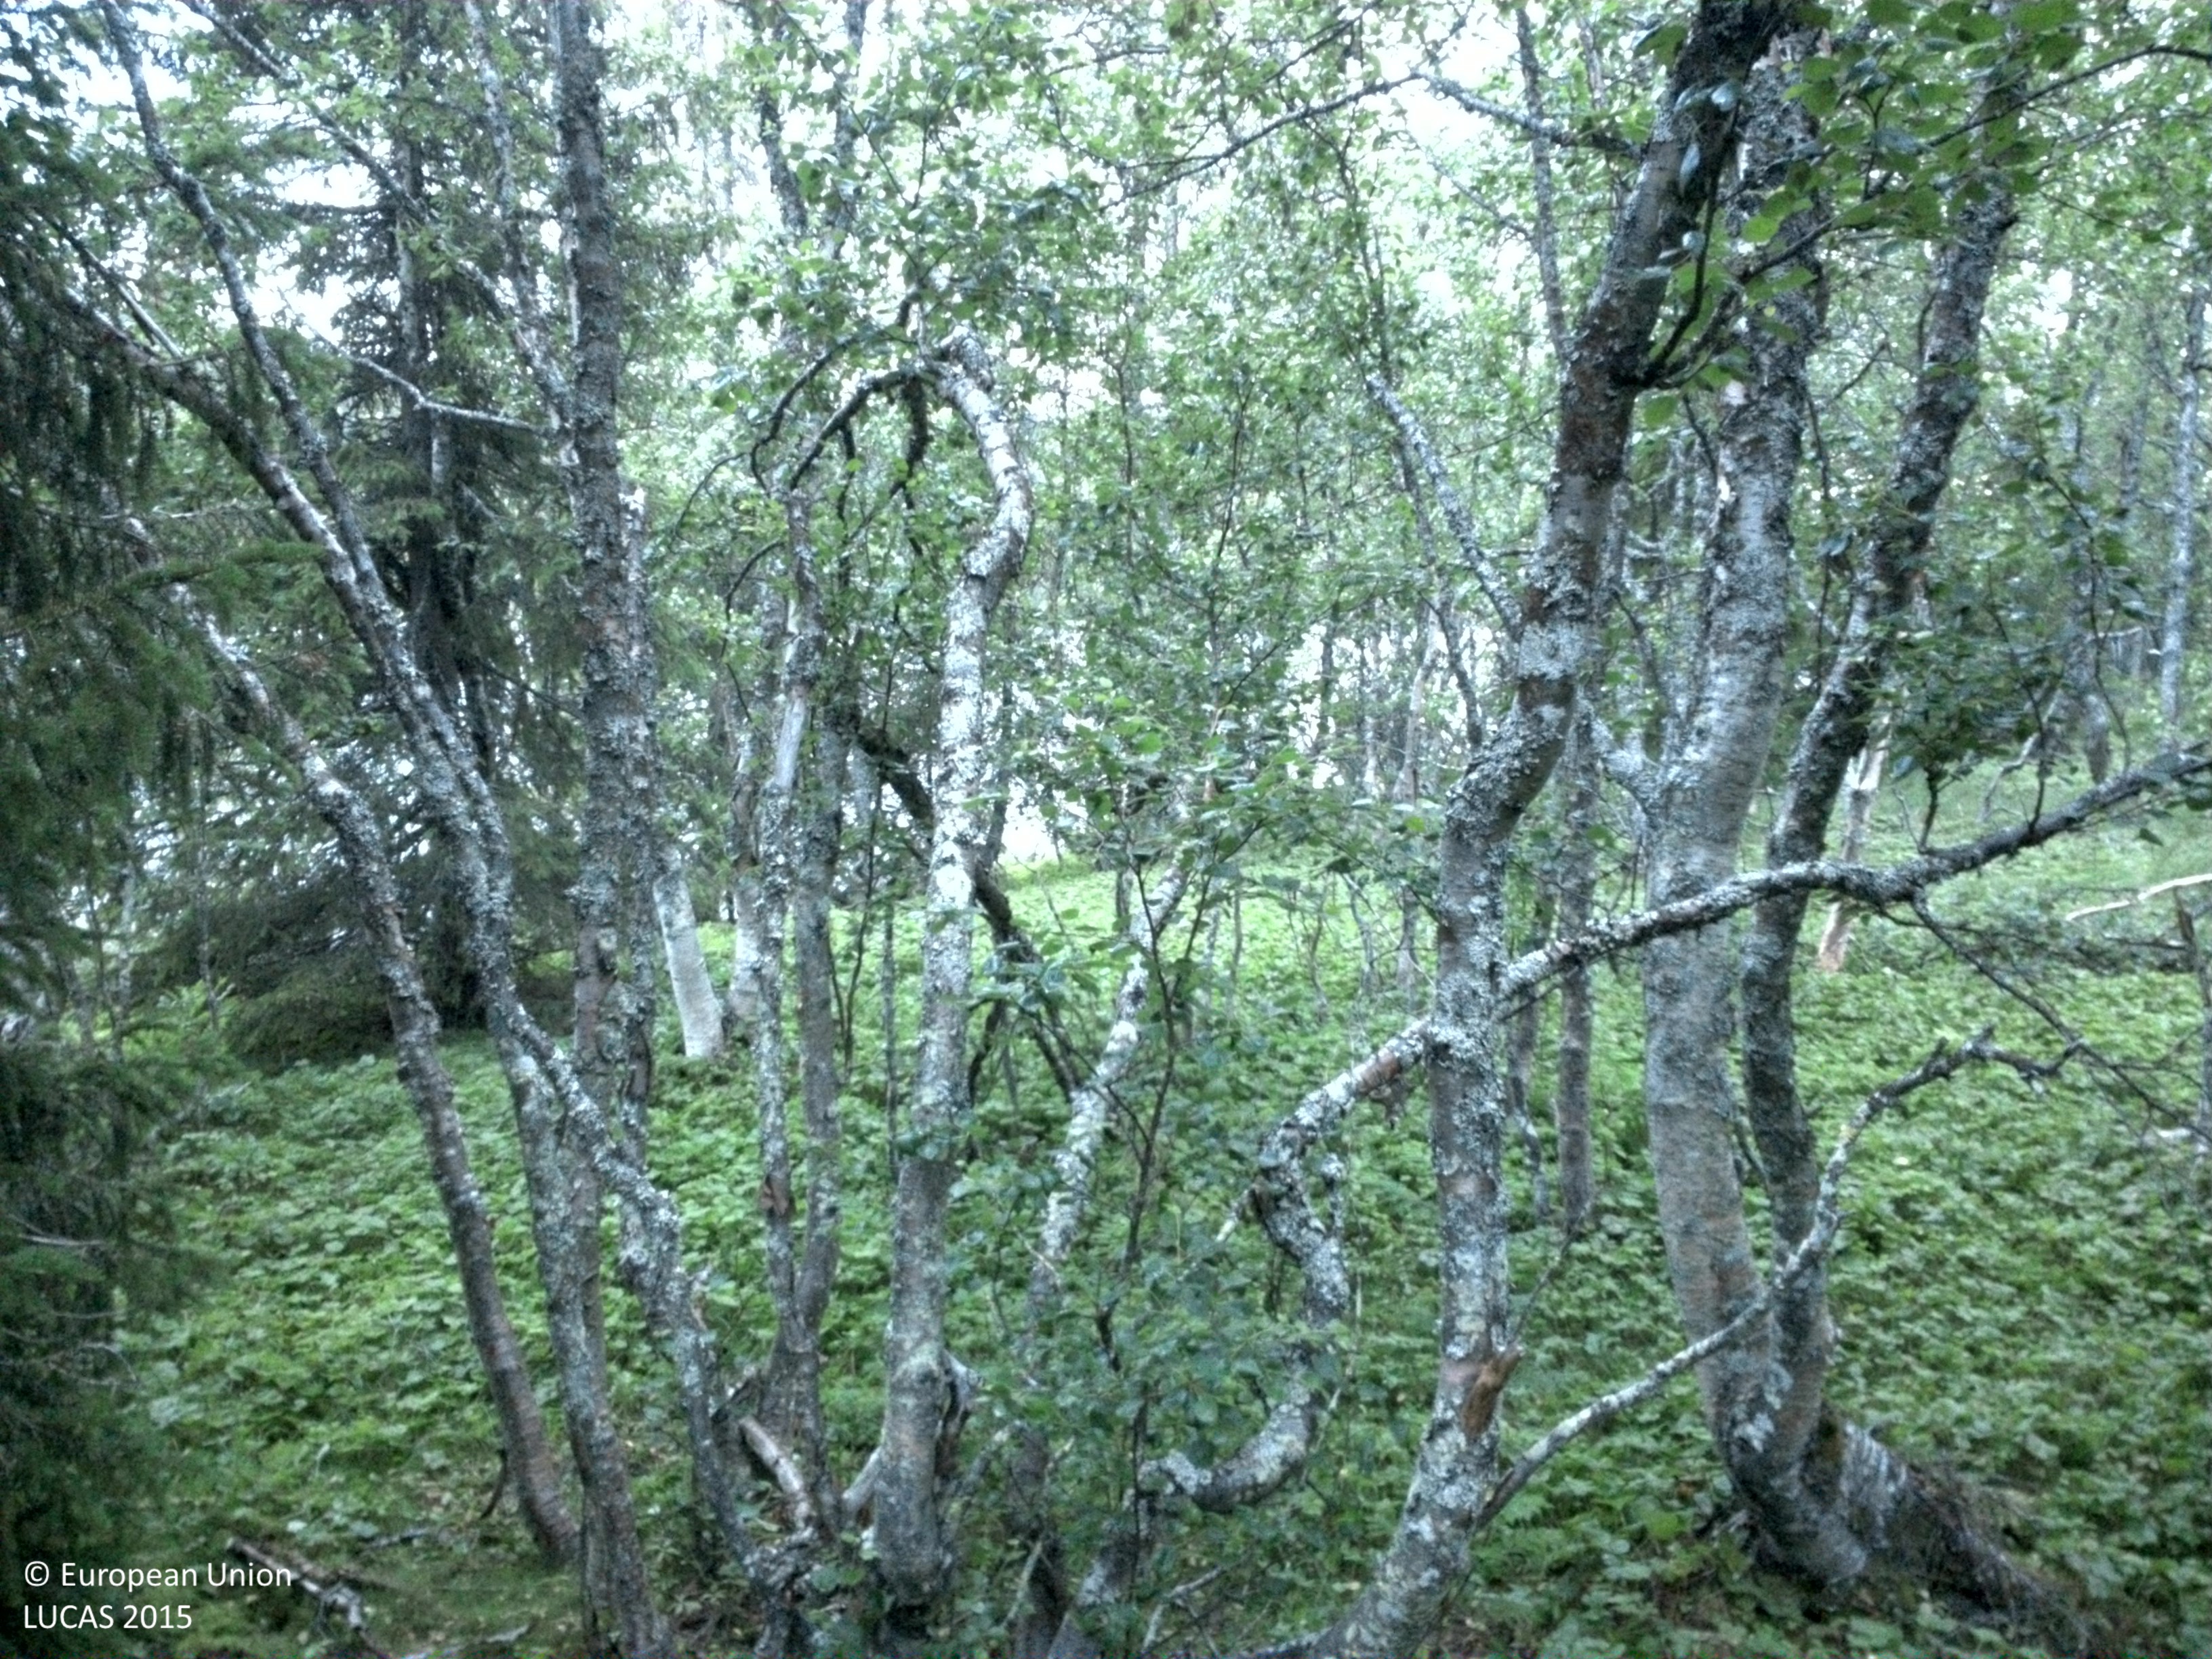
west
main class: Woodland
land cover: Spruce dominated mixed woodland
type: boreal forest
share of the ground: 50 - 75 %
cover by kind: herbaceous plants 45 %, broadleaved forest trees 40 %, coniferous forest trees 15 %
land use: Amenities, museums, leisure
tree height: > 5 m
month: August
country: SE
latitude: 64.9686
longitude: 15.6227
